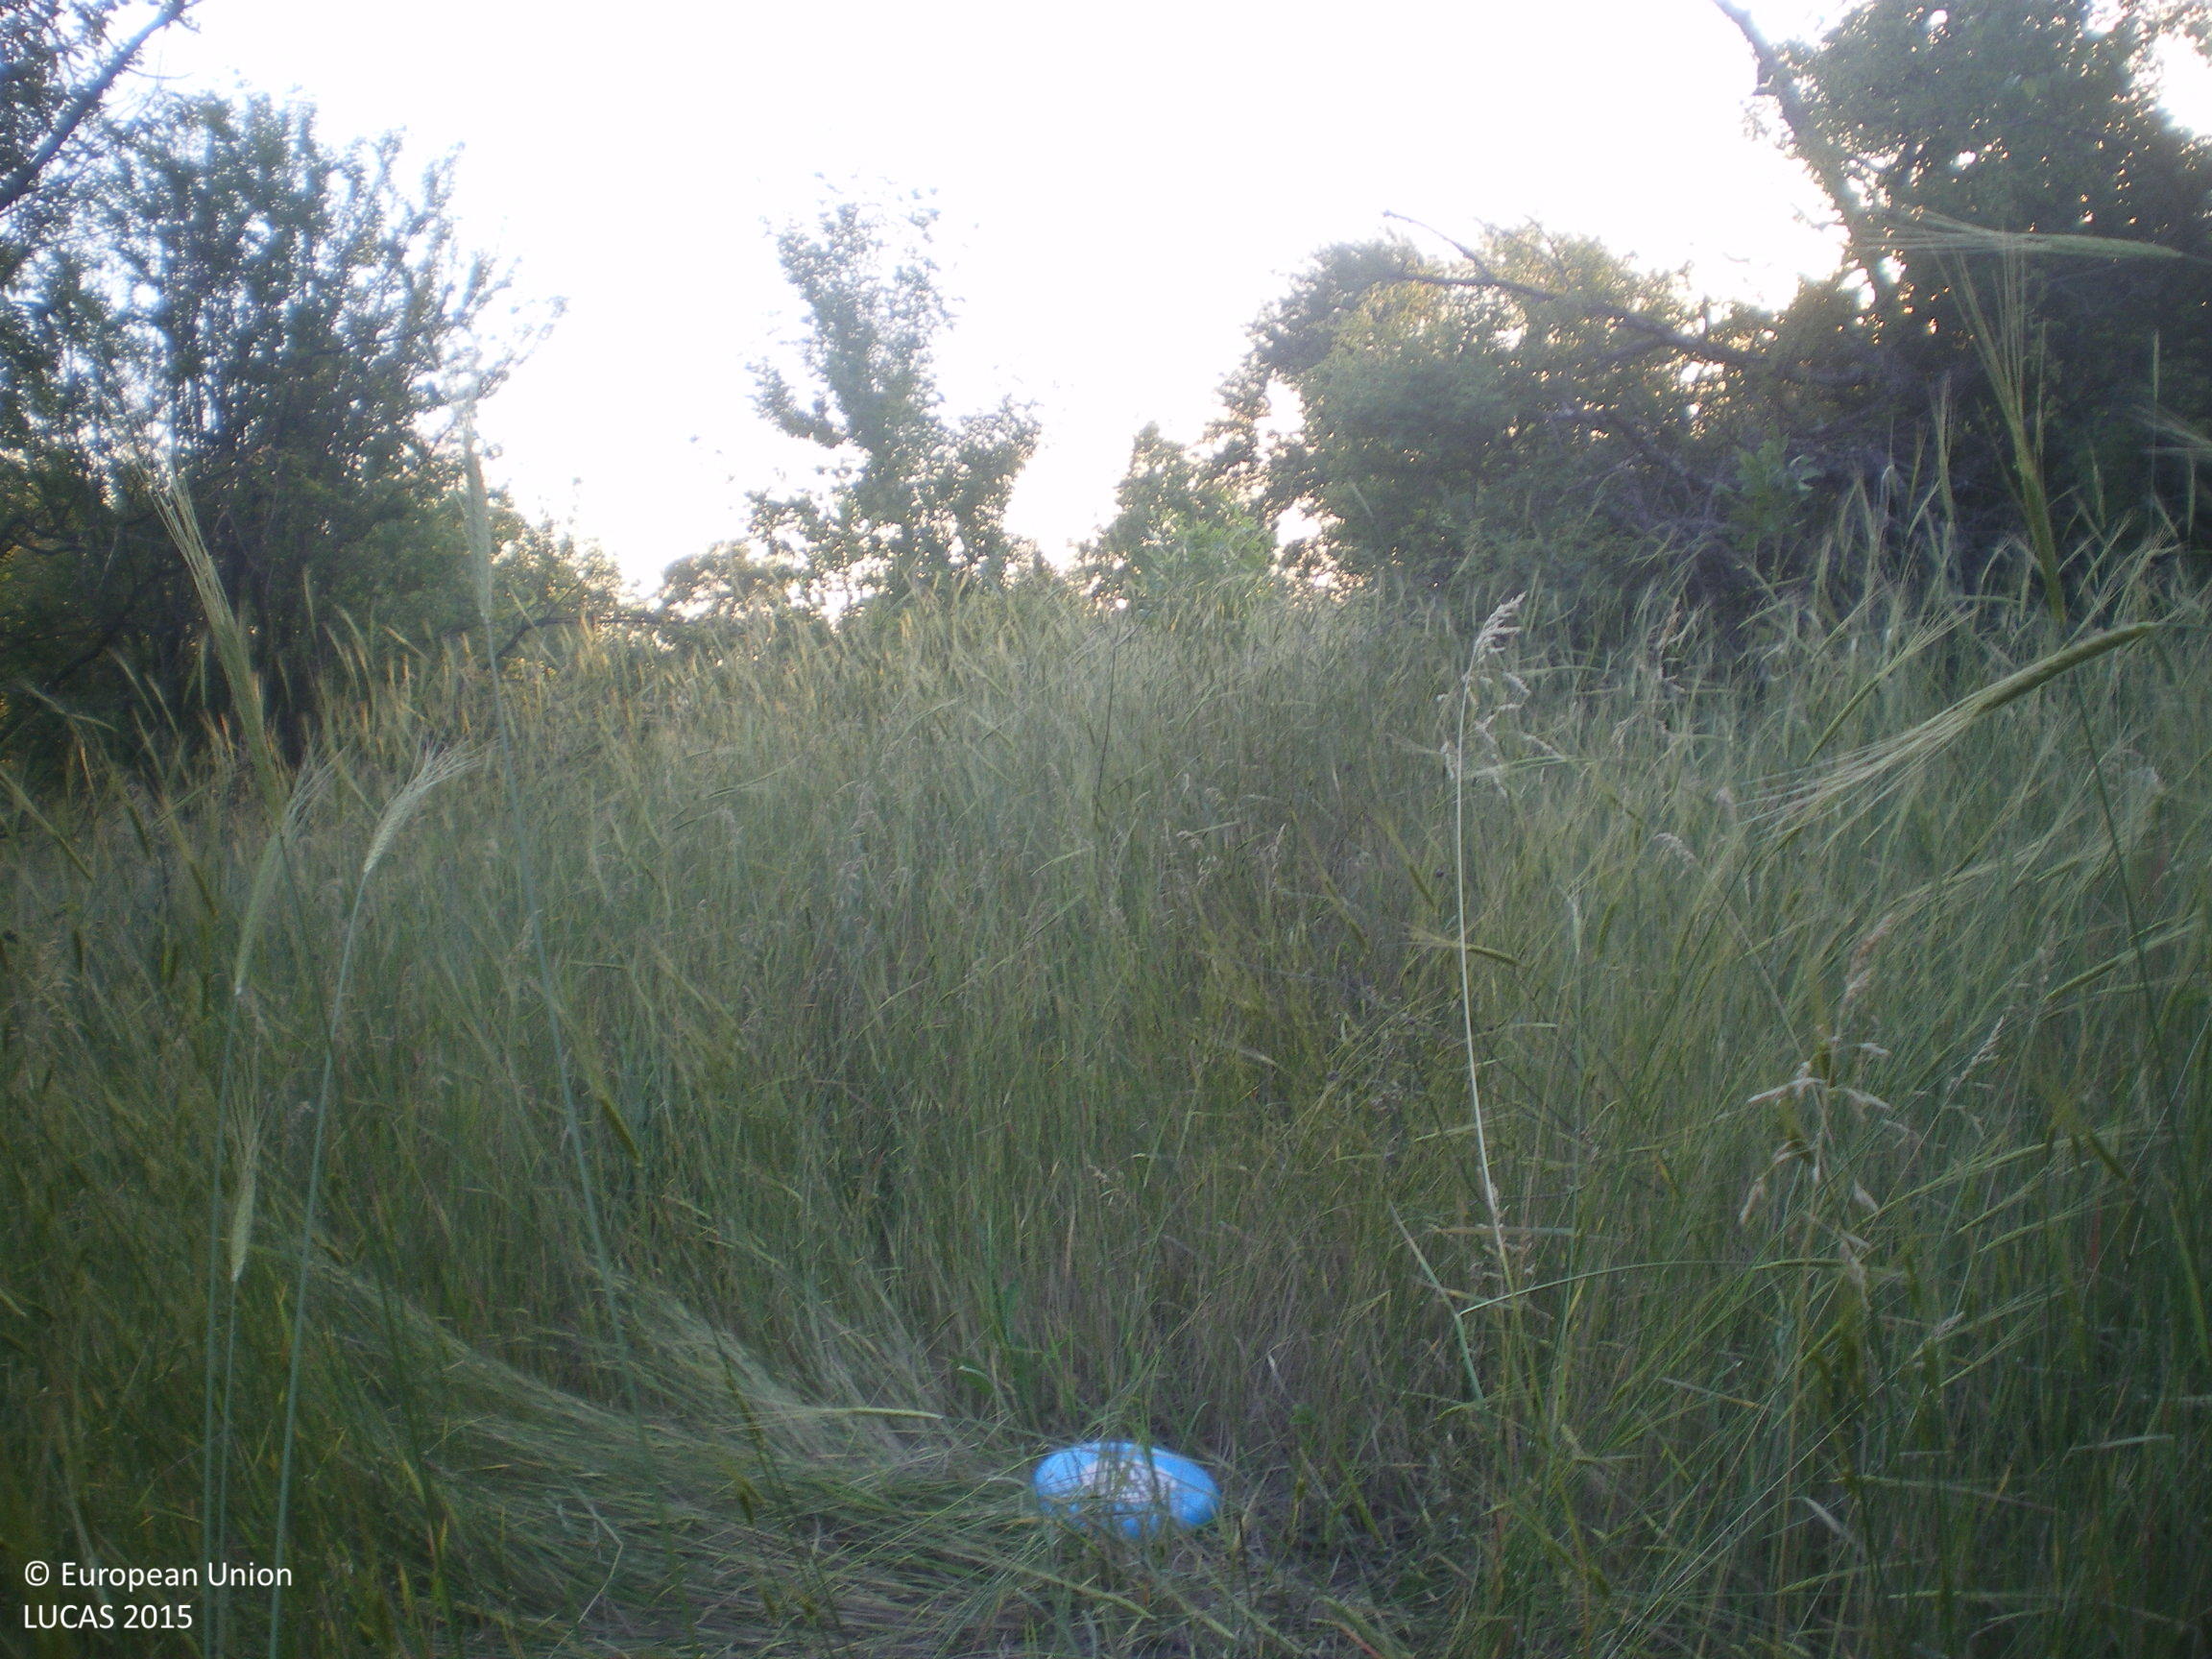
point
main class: Woodland
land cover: Broadleaved woodland
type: mesophytic deciduous forest
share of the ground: 25 - 50 %
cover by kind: broadleaved forest trees 50 %, herbaceous plants 35 %, shrubs 15 %
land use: Semi-natural and natural areas not in use
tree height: > 5 m
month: June
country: BG
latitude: 42.3857
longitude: 25.1600
